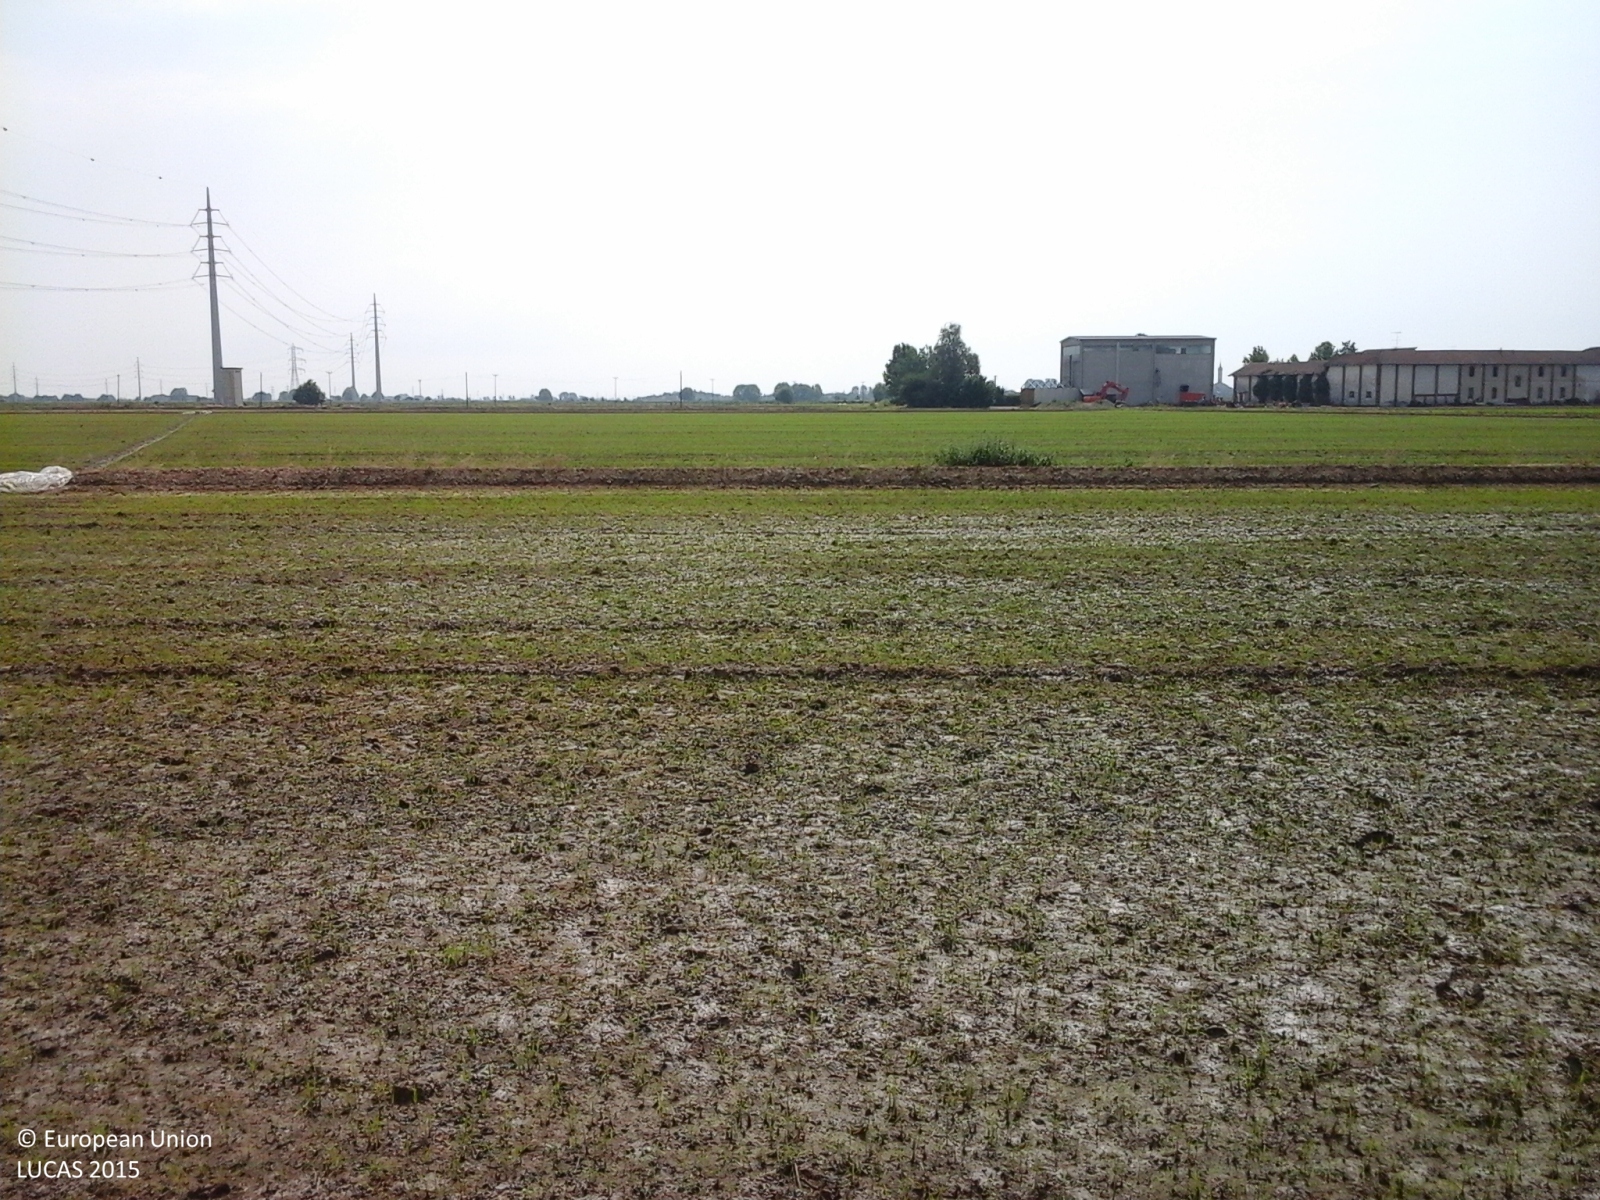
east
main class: Cropland
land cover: Rice
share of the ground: 10 - 25 %
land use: Agriculture (excluding fallow land and kitchen gardens)
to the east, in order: Rice; Other structural elements; Rice; Ditches and canals; Rice; Ditches and canals; Rice; Ditches and canals; Rice; Ditches and canals; Rice; Ditches and canals; Rice; Other structural elements; Rice; Ditches and canals; Rice; Ditches and canals; Rice; Ditches and canals; Rice
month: May
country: IT
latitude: 45.2749
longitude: 8.3331
